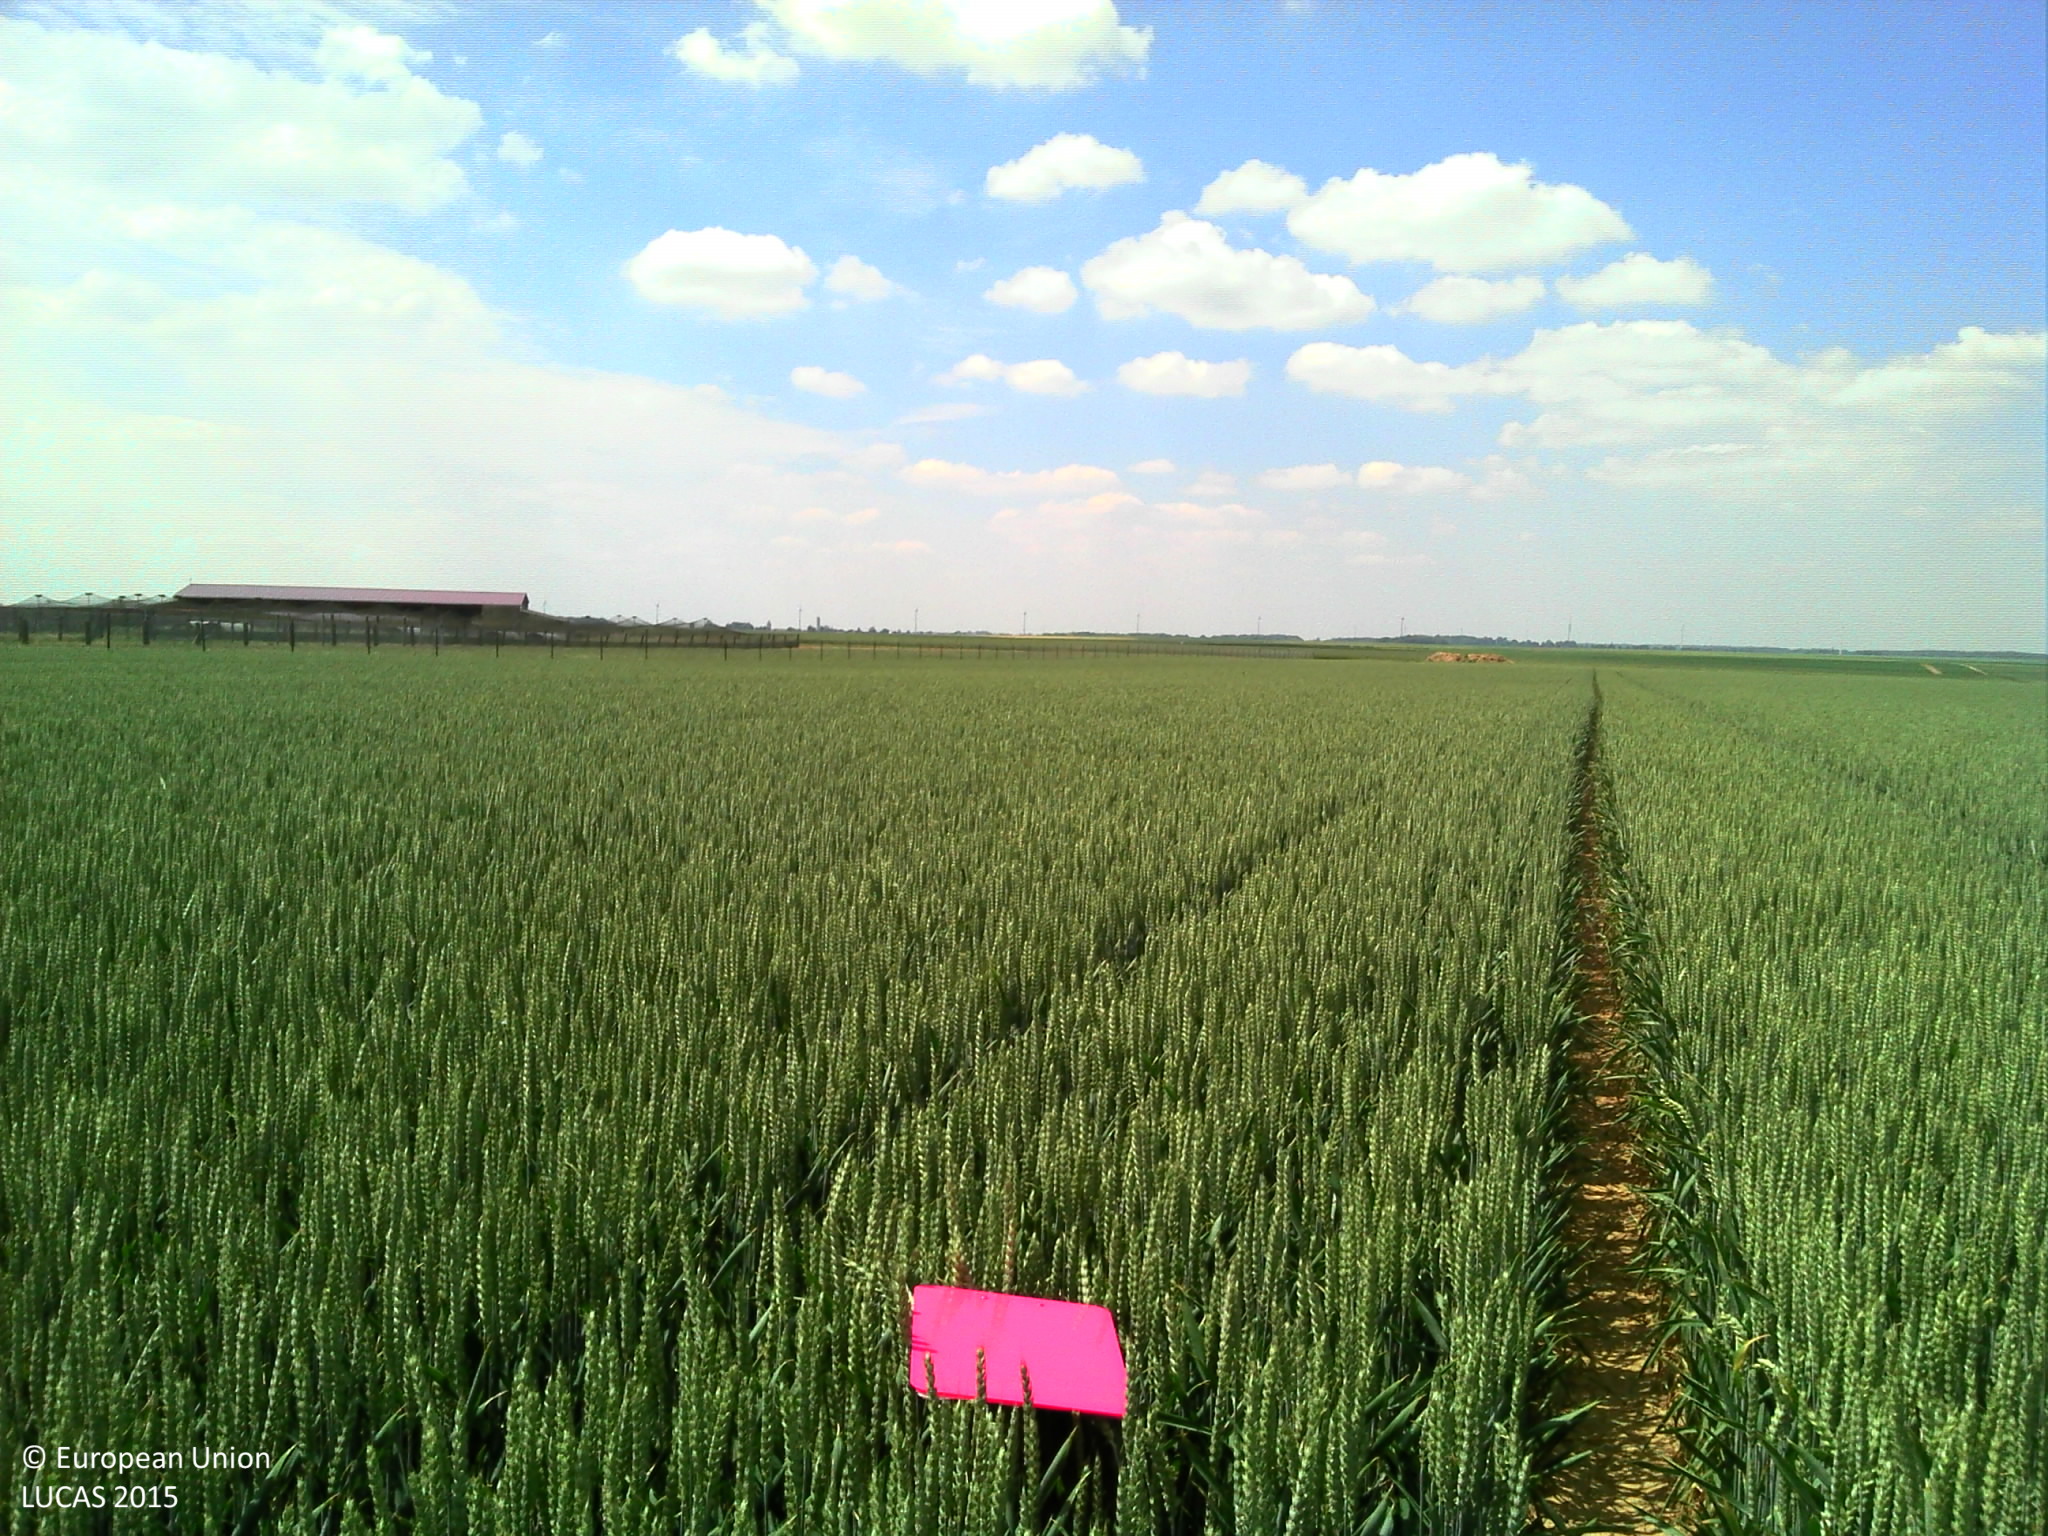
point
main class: Cropland
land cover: Common wheat
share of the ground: > 75 %
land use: Agriculture (excluding fallow land and kitchen gardens)
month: June
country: FR
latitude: 49.5583
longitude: 2.5089
